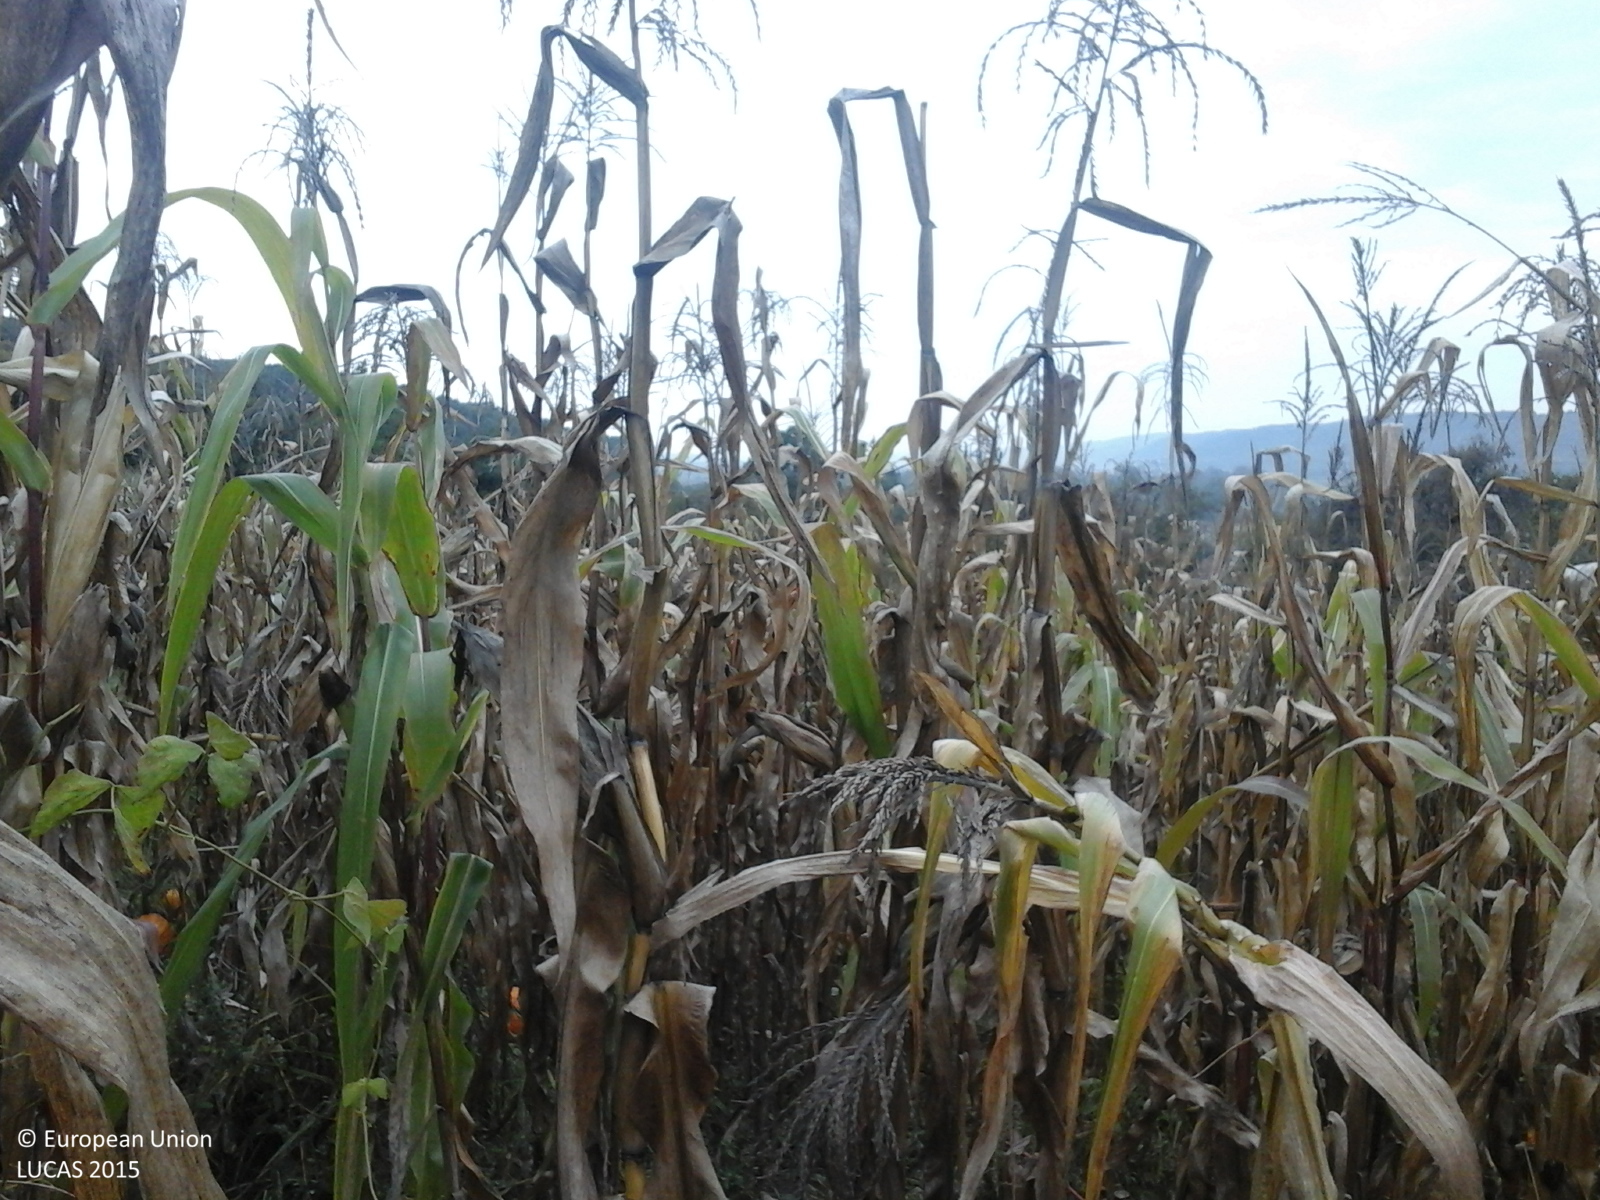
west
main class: Cropland
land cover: Maize
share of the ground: > 75 %
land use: Agriculture (excluding fallow land and kitchen gardens)
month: October
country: RO
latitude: 46.4012
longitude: 24.7499
